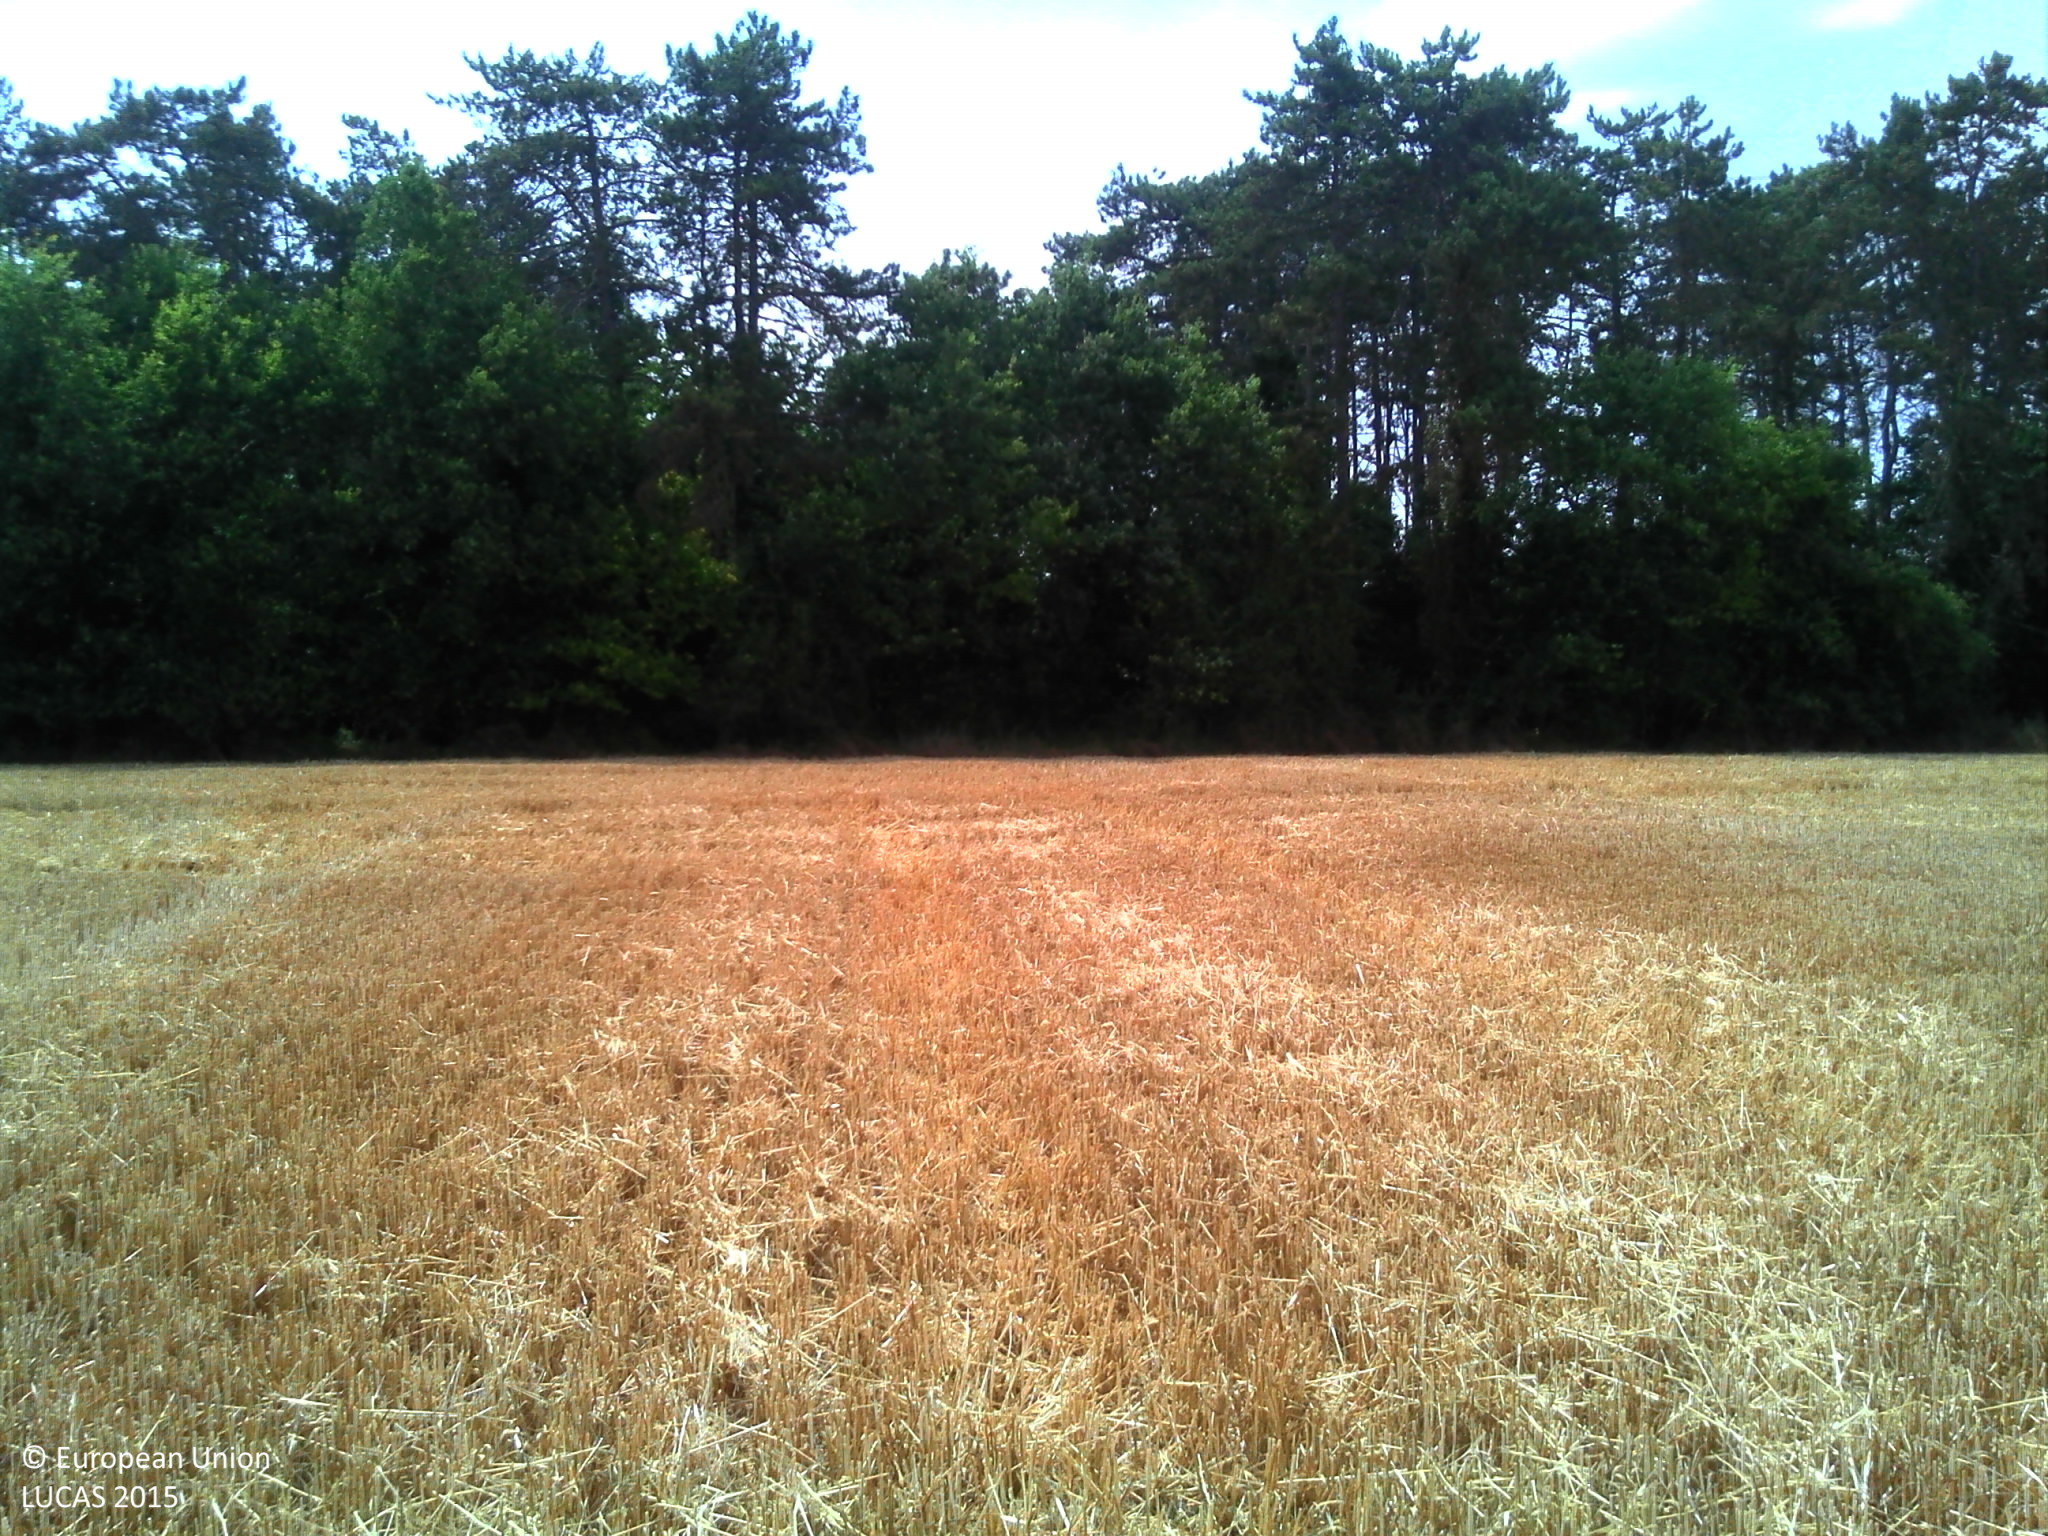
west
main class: Cropland
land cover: Common wheat
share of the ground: > 75 %
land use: Agriculture (excluding fallow land and kitchen gardens)
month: July
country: FR
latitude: 47.9162
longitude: 2.8067
